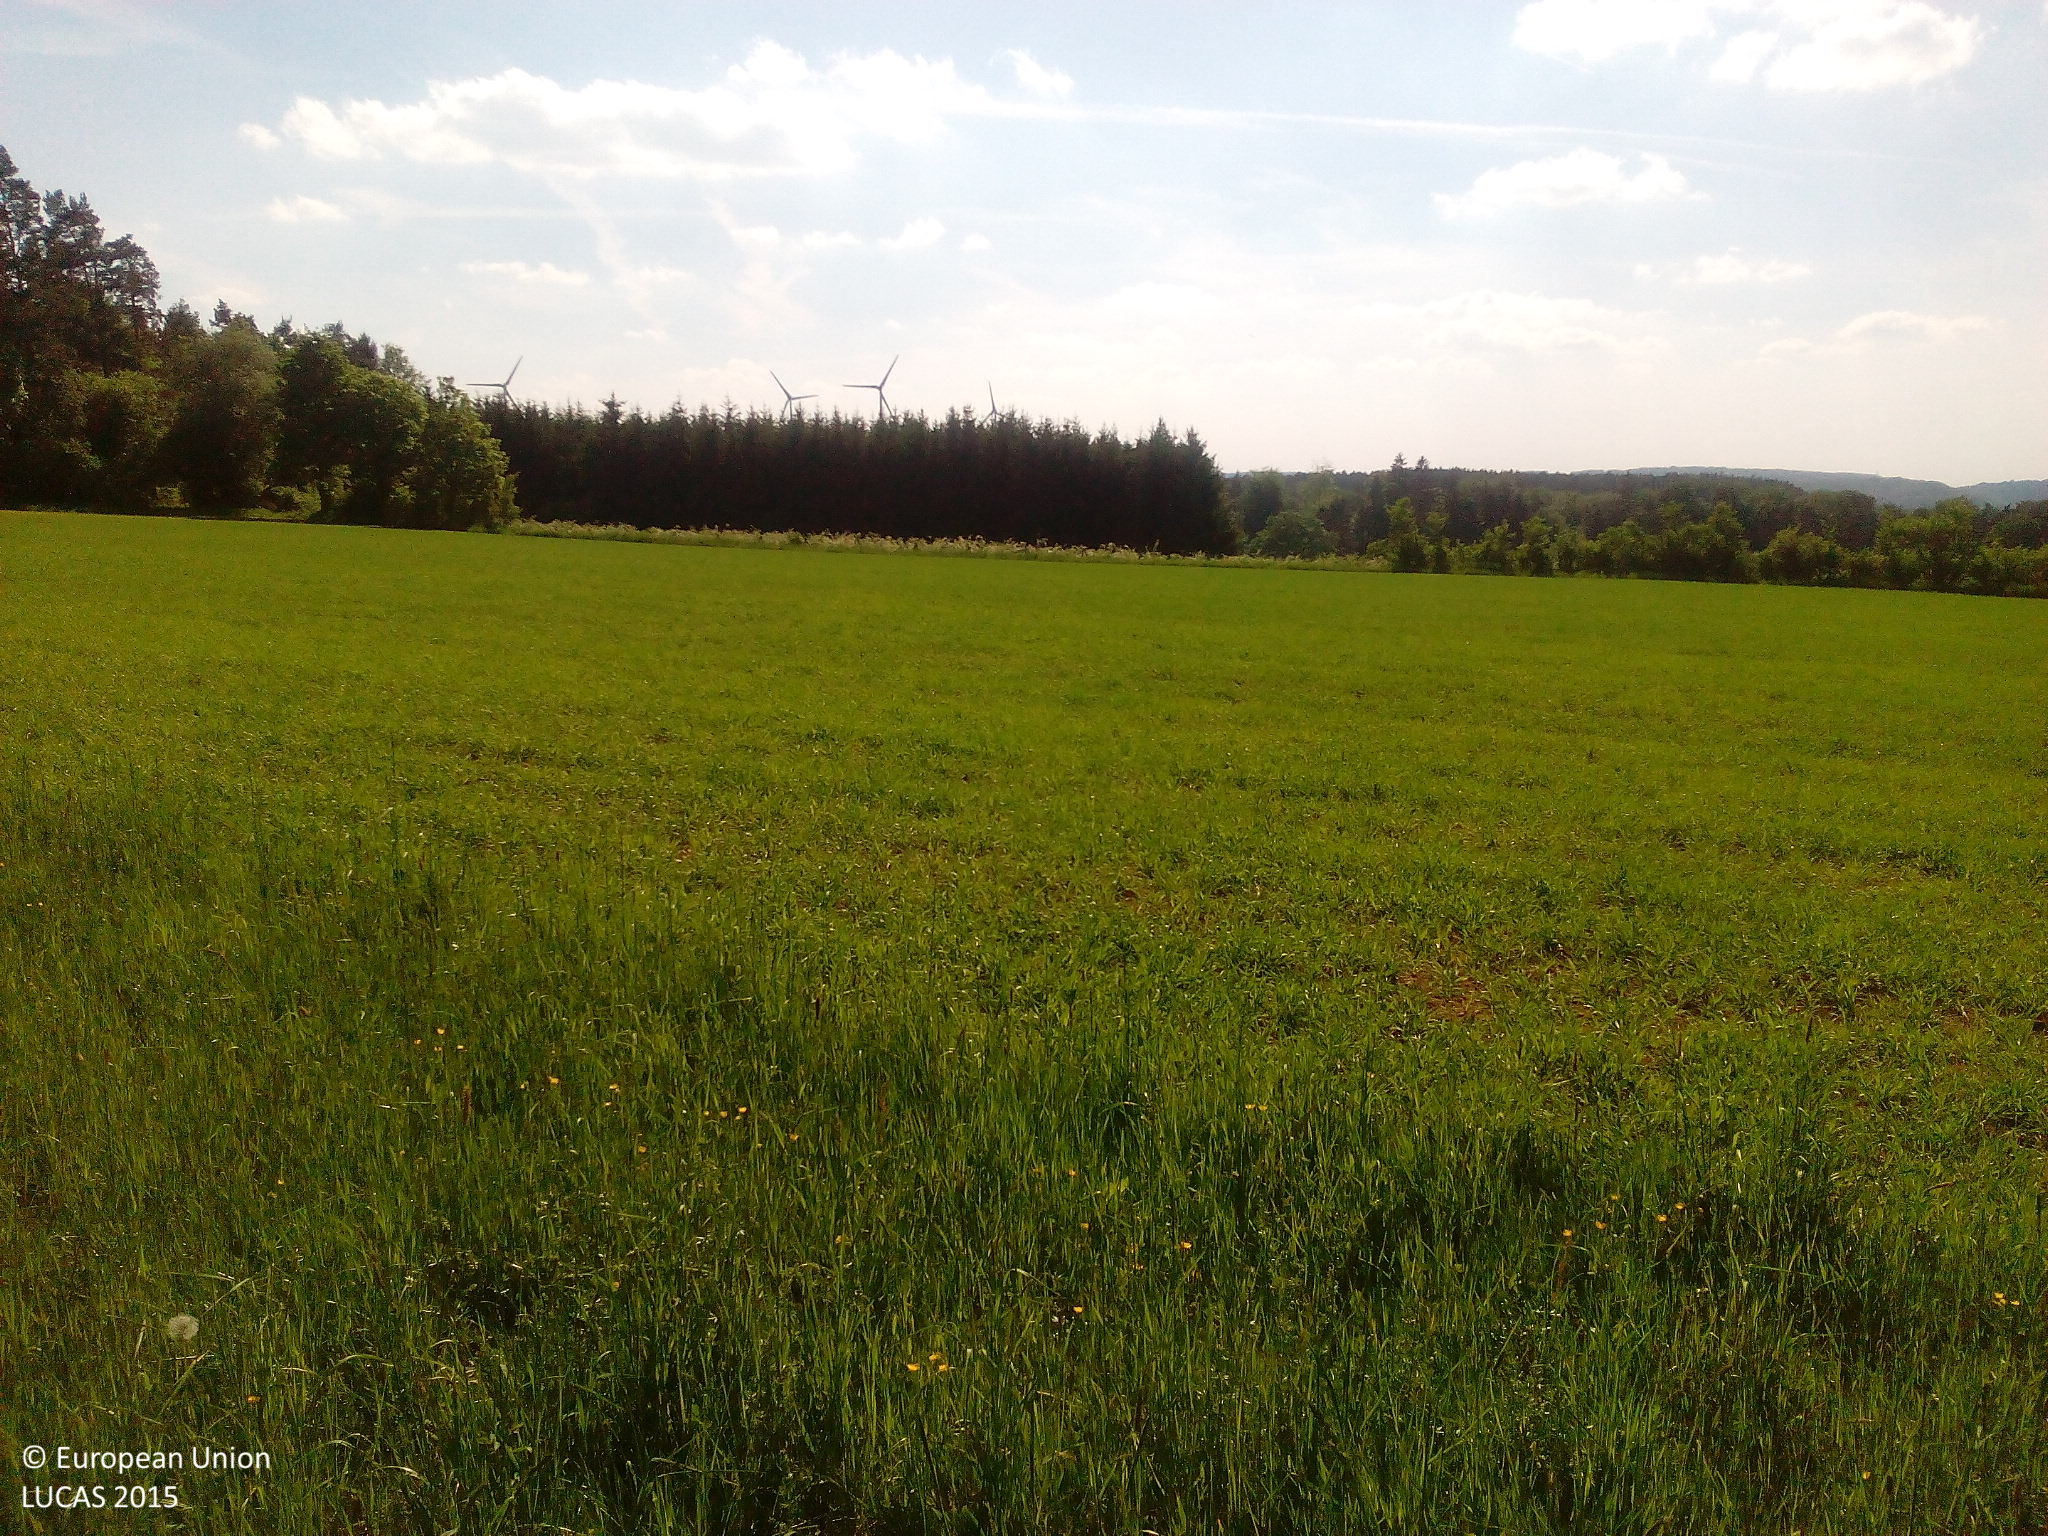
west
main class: Grassland
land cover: Grassland without tree/shrub cover
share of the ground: > 75 %
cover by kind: herbaceous plants 100 %
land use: Agriculture (excluding fallow land and kitchen gardens)
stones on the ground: < 10 %
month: May
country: DE
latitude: 49.4372
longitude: 11.4751
